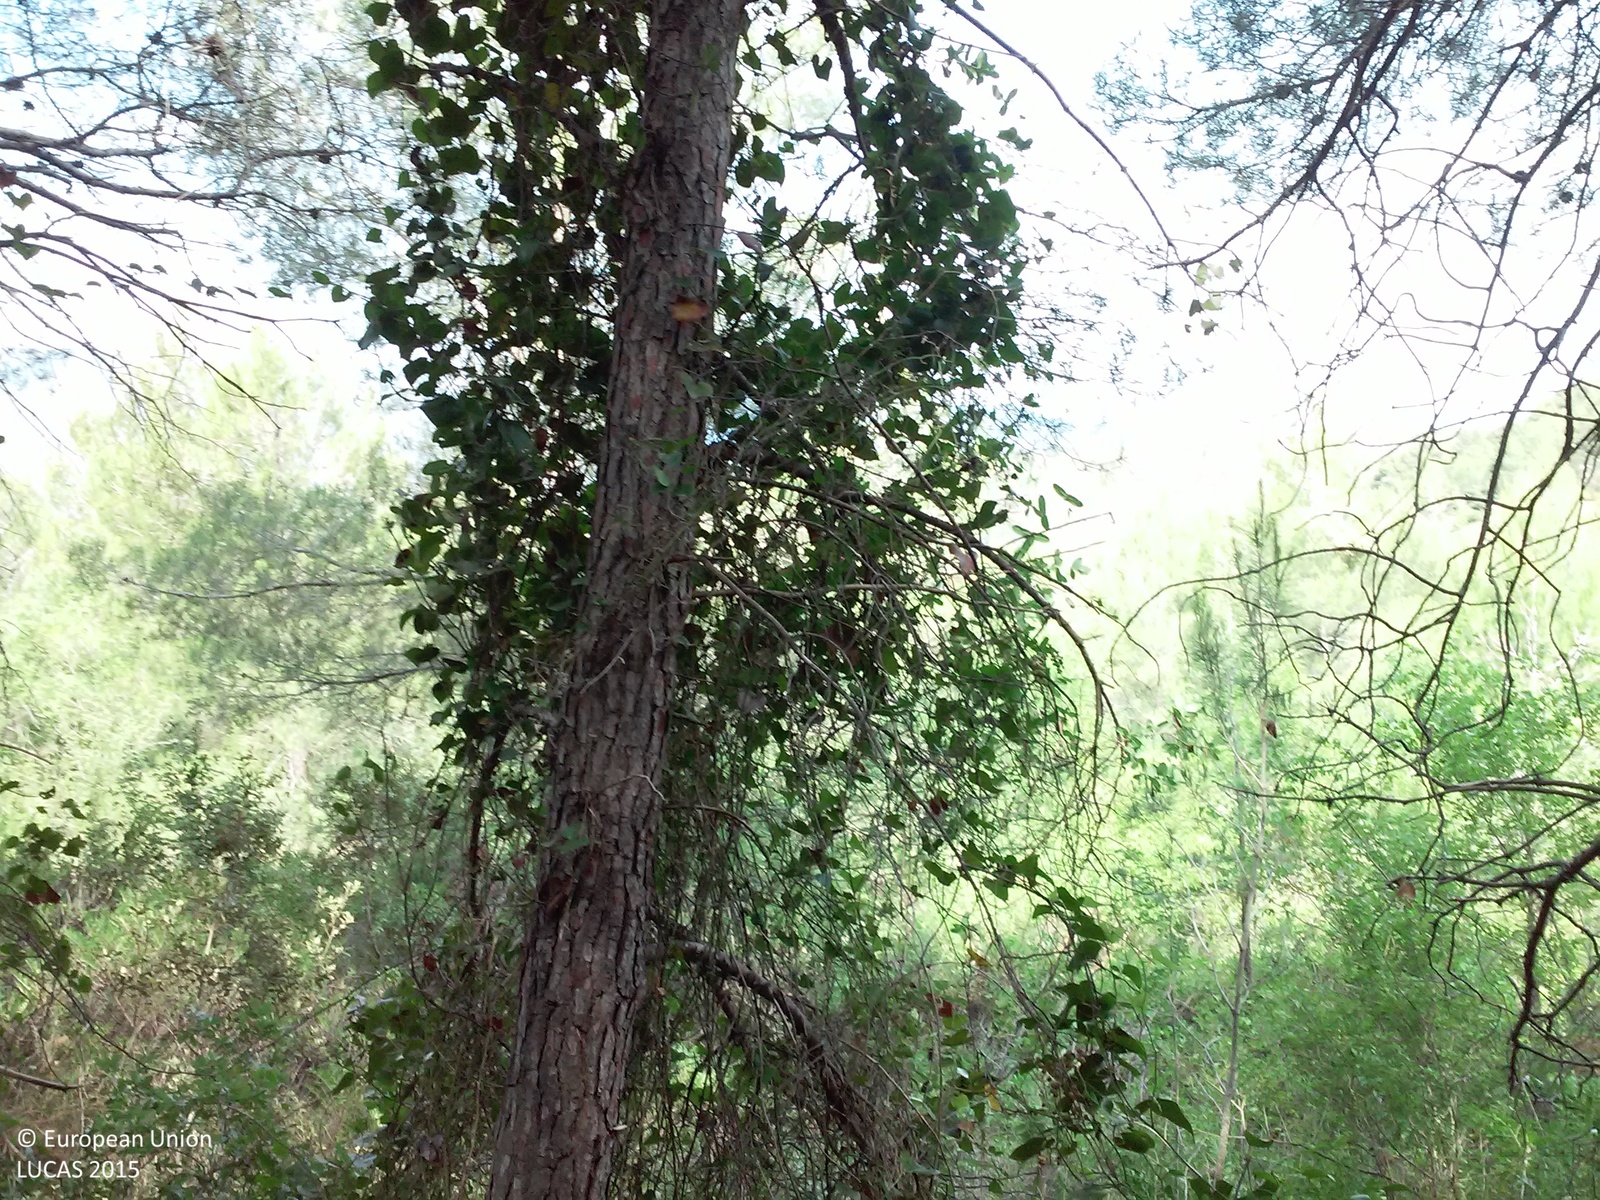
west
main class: Woodland
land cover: Pine dominated coniferous woodland
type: coniferous forest of the mediterranean region
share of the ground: > 75 %
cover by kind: coniferous forest trees 70 %, broadleaved forest trees 10 %, shrubs 10 %, herbaceous plants 10 %
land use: Semi-natural and natural areas not in use
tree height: > 5 m
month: June
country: ES
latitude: 41.3447
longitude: 1.2081
